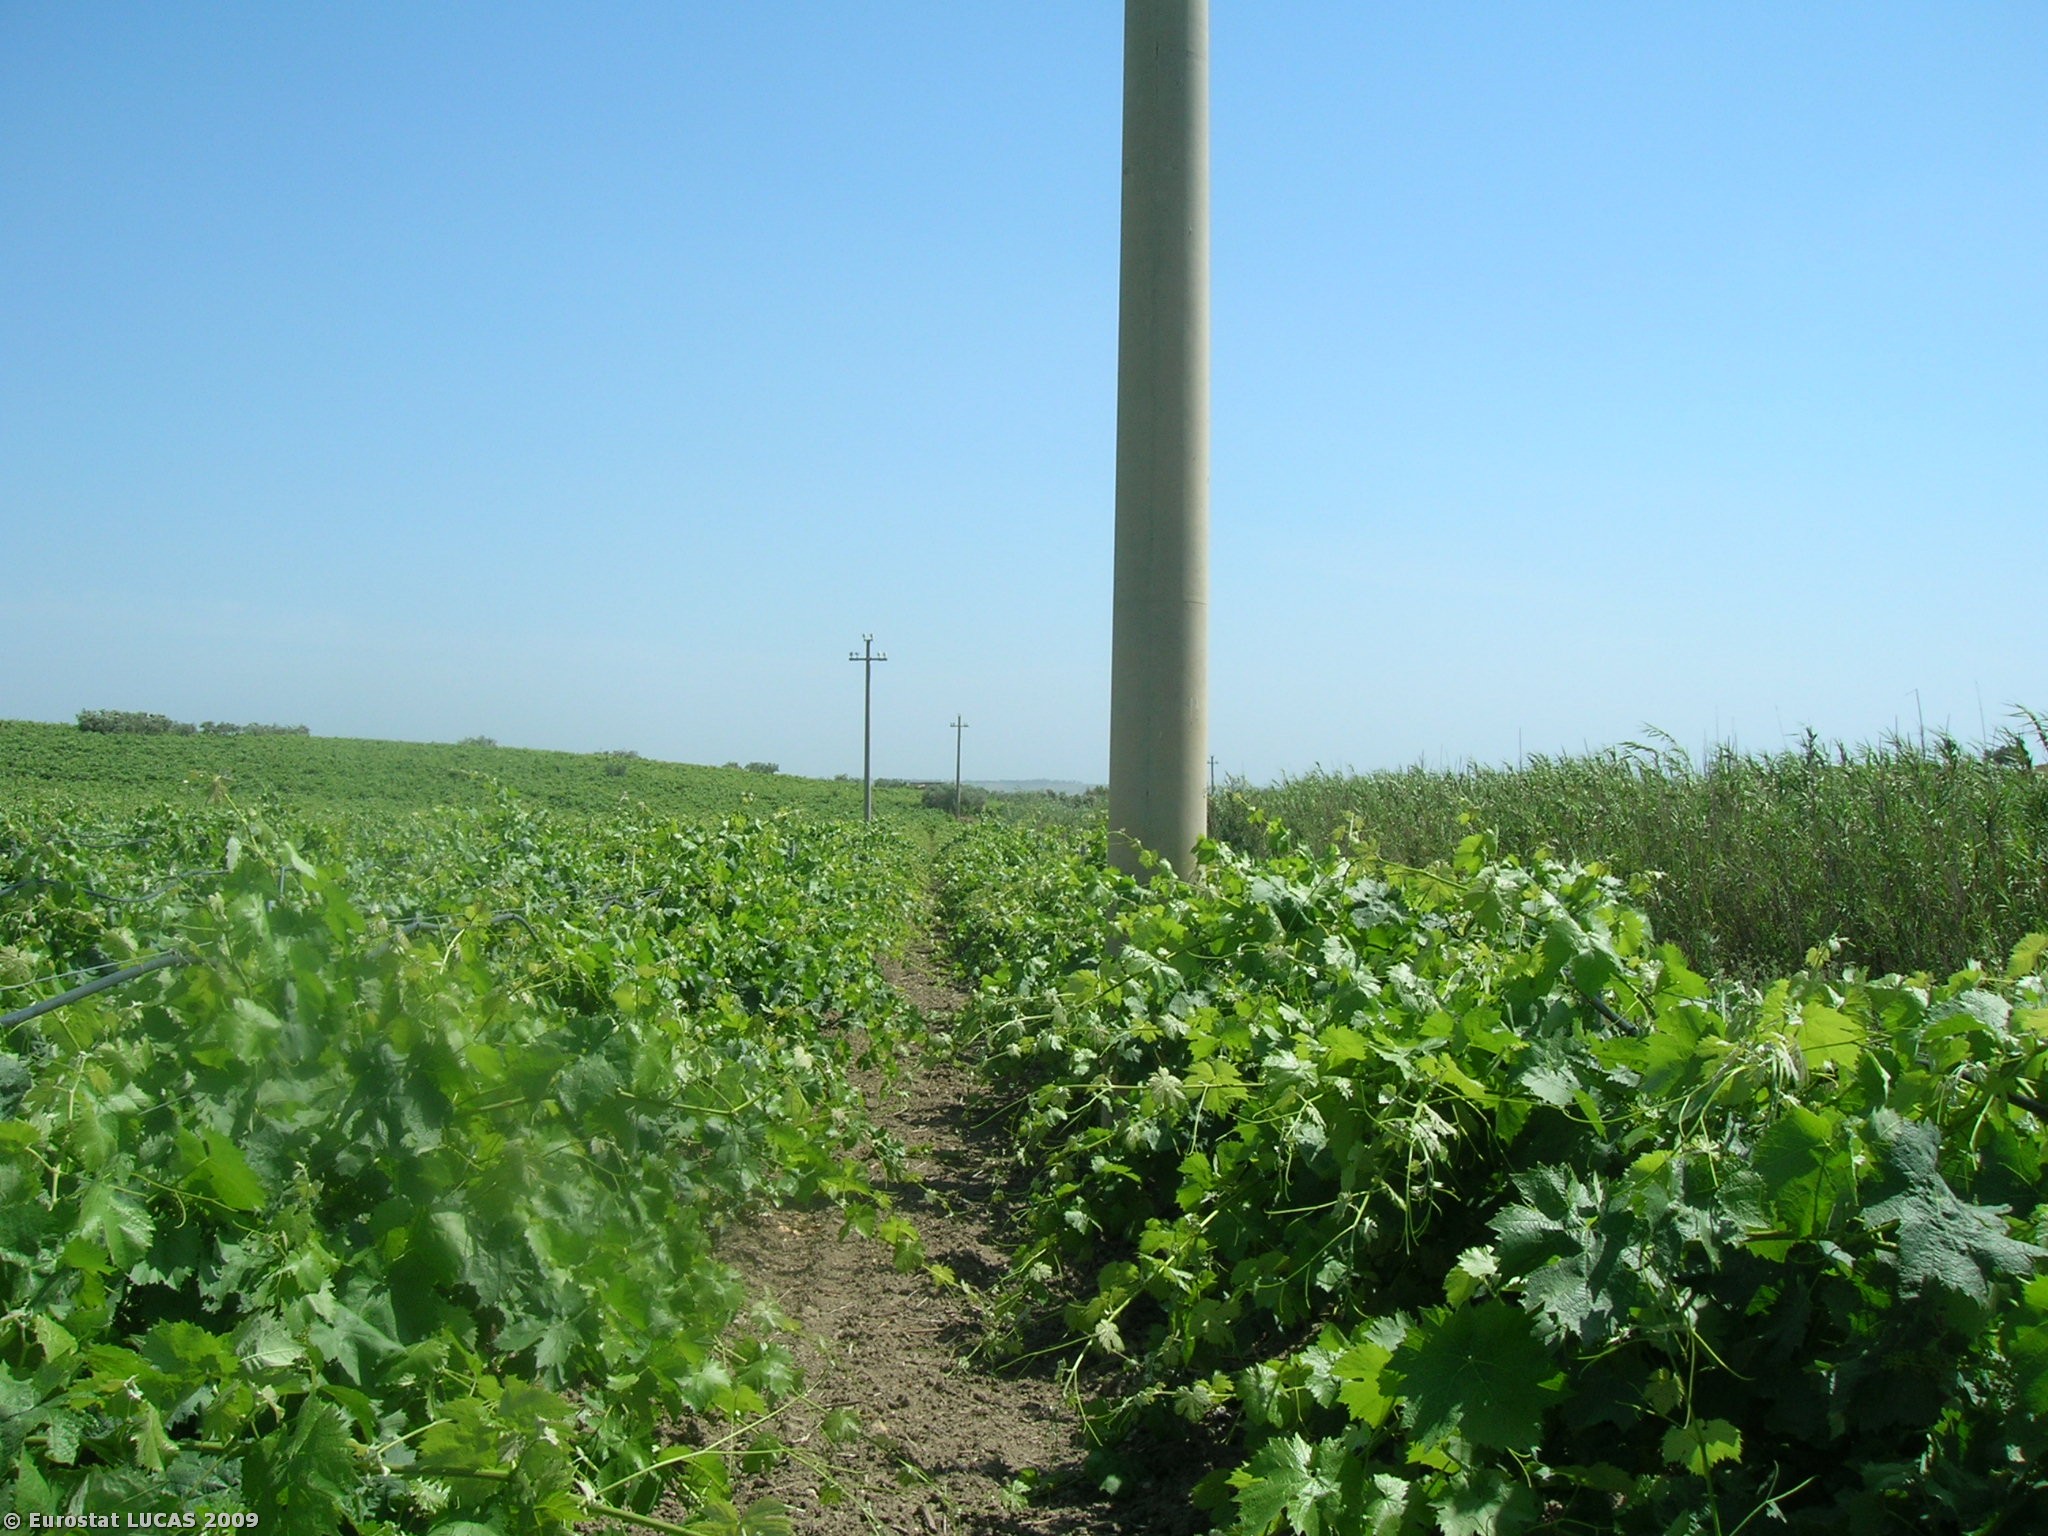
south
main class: Cropland
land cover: Vineyards
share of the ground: 50 - 75 %
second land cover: Bare land
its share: 50 - 75 %
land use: Agriculture (excluding fallow land and kitchen gardens)
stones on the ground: < 10 %
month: May
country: IT
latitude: 37.7101
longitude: 12.6683
